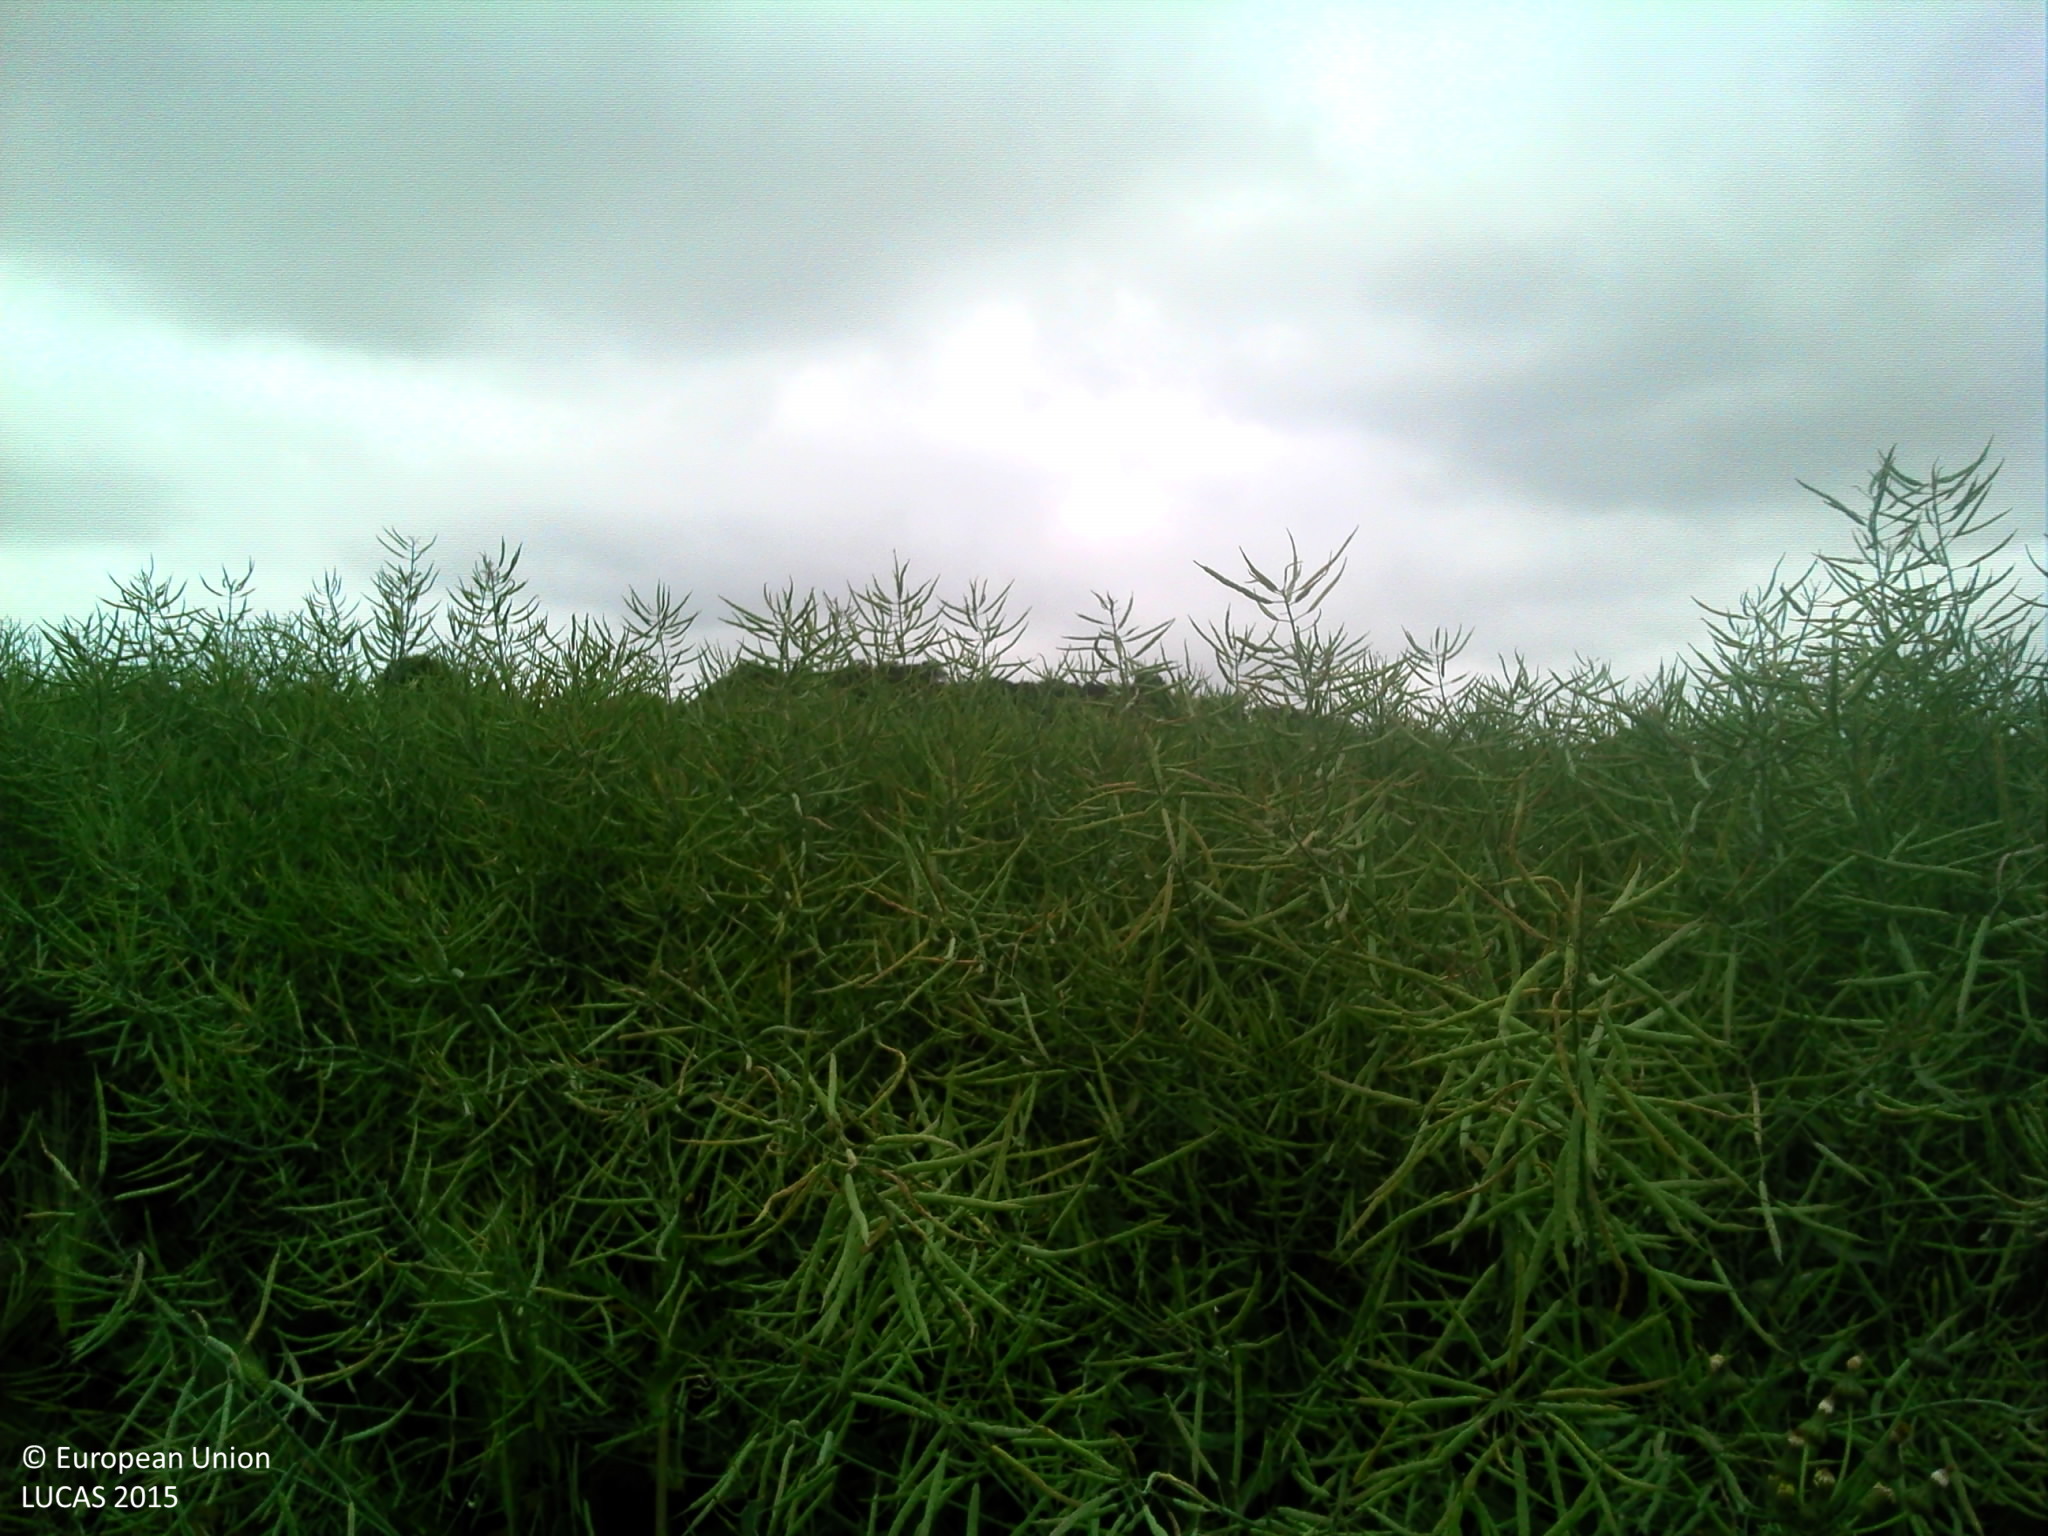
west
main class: Cropland
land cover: Rape and turnip rape
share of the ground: > 75 %
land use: Agriculture (excluding fallow land and kitchen gardens)
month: May
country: FR
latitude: 48.2263
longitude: -0.1397
